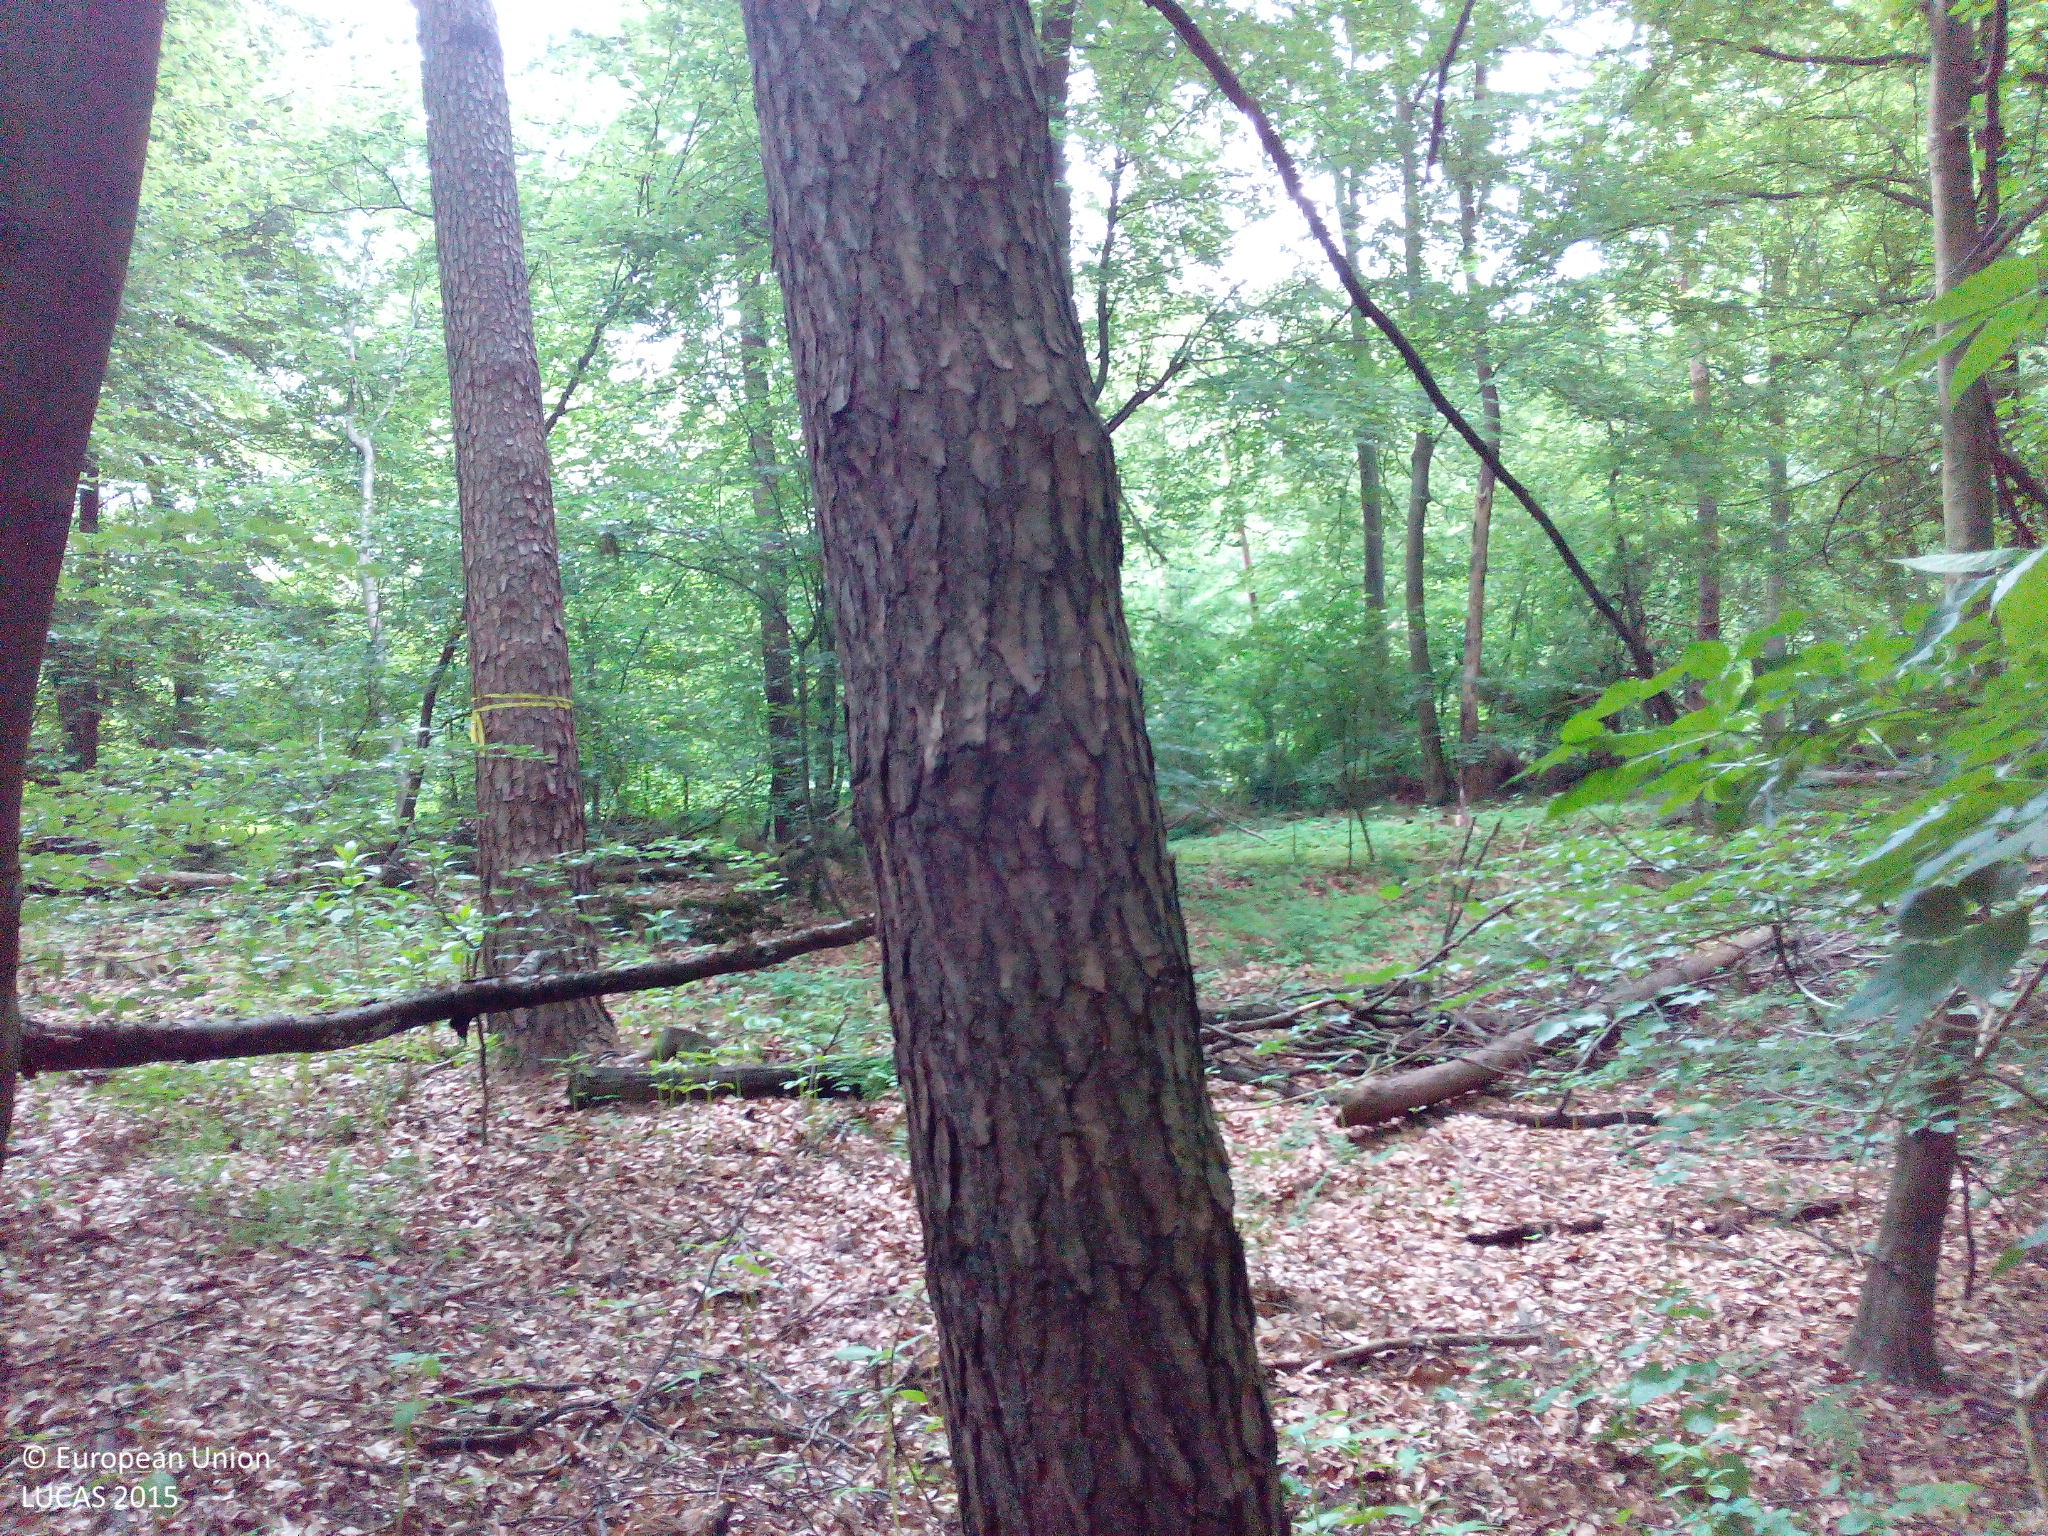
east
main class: Woodland
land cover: Broadleaved woodland
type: beech forest
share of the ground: > 75 %
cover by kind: broadleaved forest trees 85 %, coniferous forest trees 5 %, herbaceous plants 5 %, unconsolidated bare surface 5 %
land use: Forestry
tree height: > 5 m
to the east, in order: Broadleaved woodland; Tracks; Grassland without tree/shrub cover; Inland fresh running water; Grassland without tree/shrub cover; Tracks; Broadleaved woodland
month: May
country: DE
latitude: 48.7837
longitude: 8.1361
